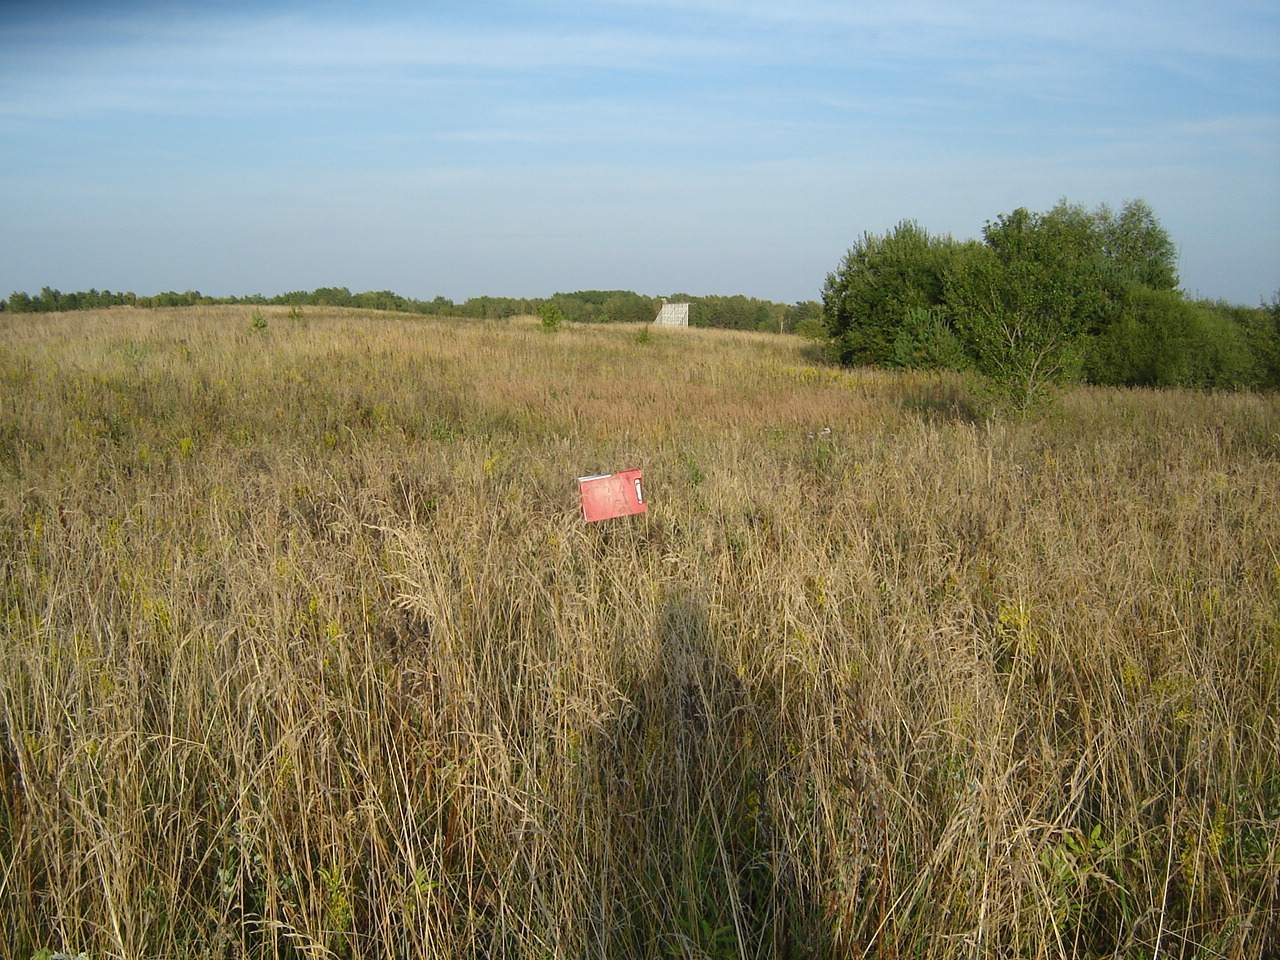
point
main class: Grassland
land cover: Grassland with sparse tree/shrub cover
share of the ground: > 75 %
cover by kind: herbaceous plants 95 %, coniferous forest trees 5 %
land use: Fallow land
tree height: < 5 m
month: August
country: LT
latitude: 54.7374
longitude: 24.9456
